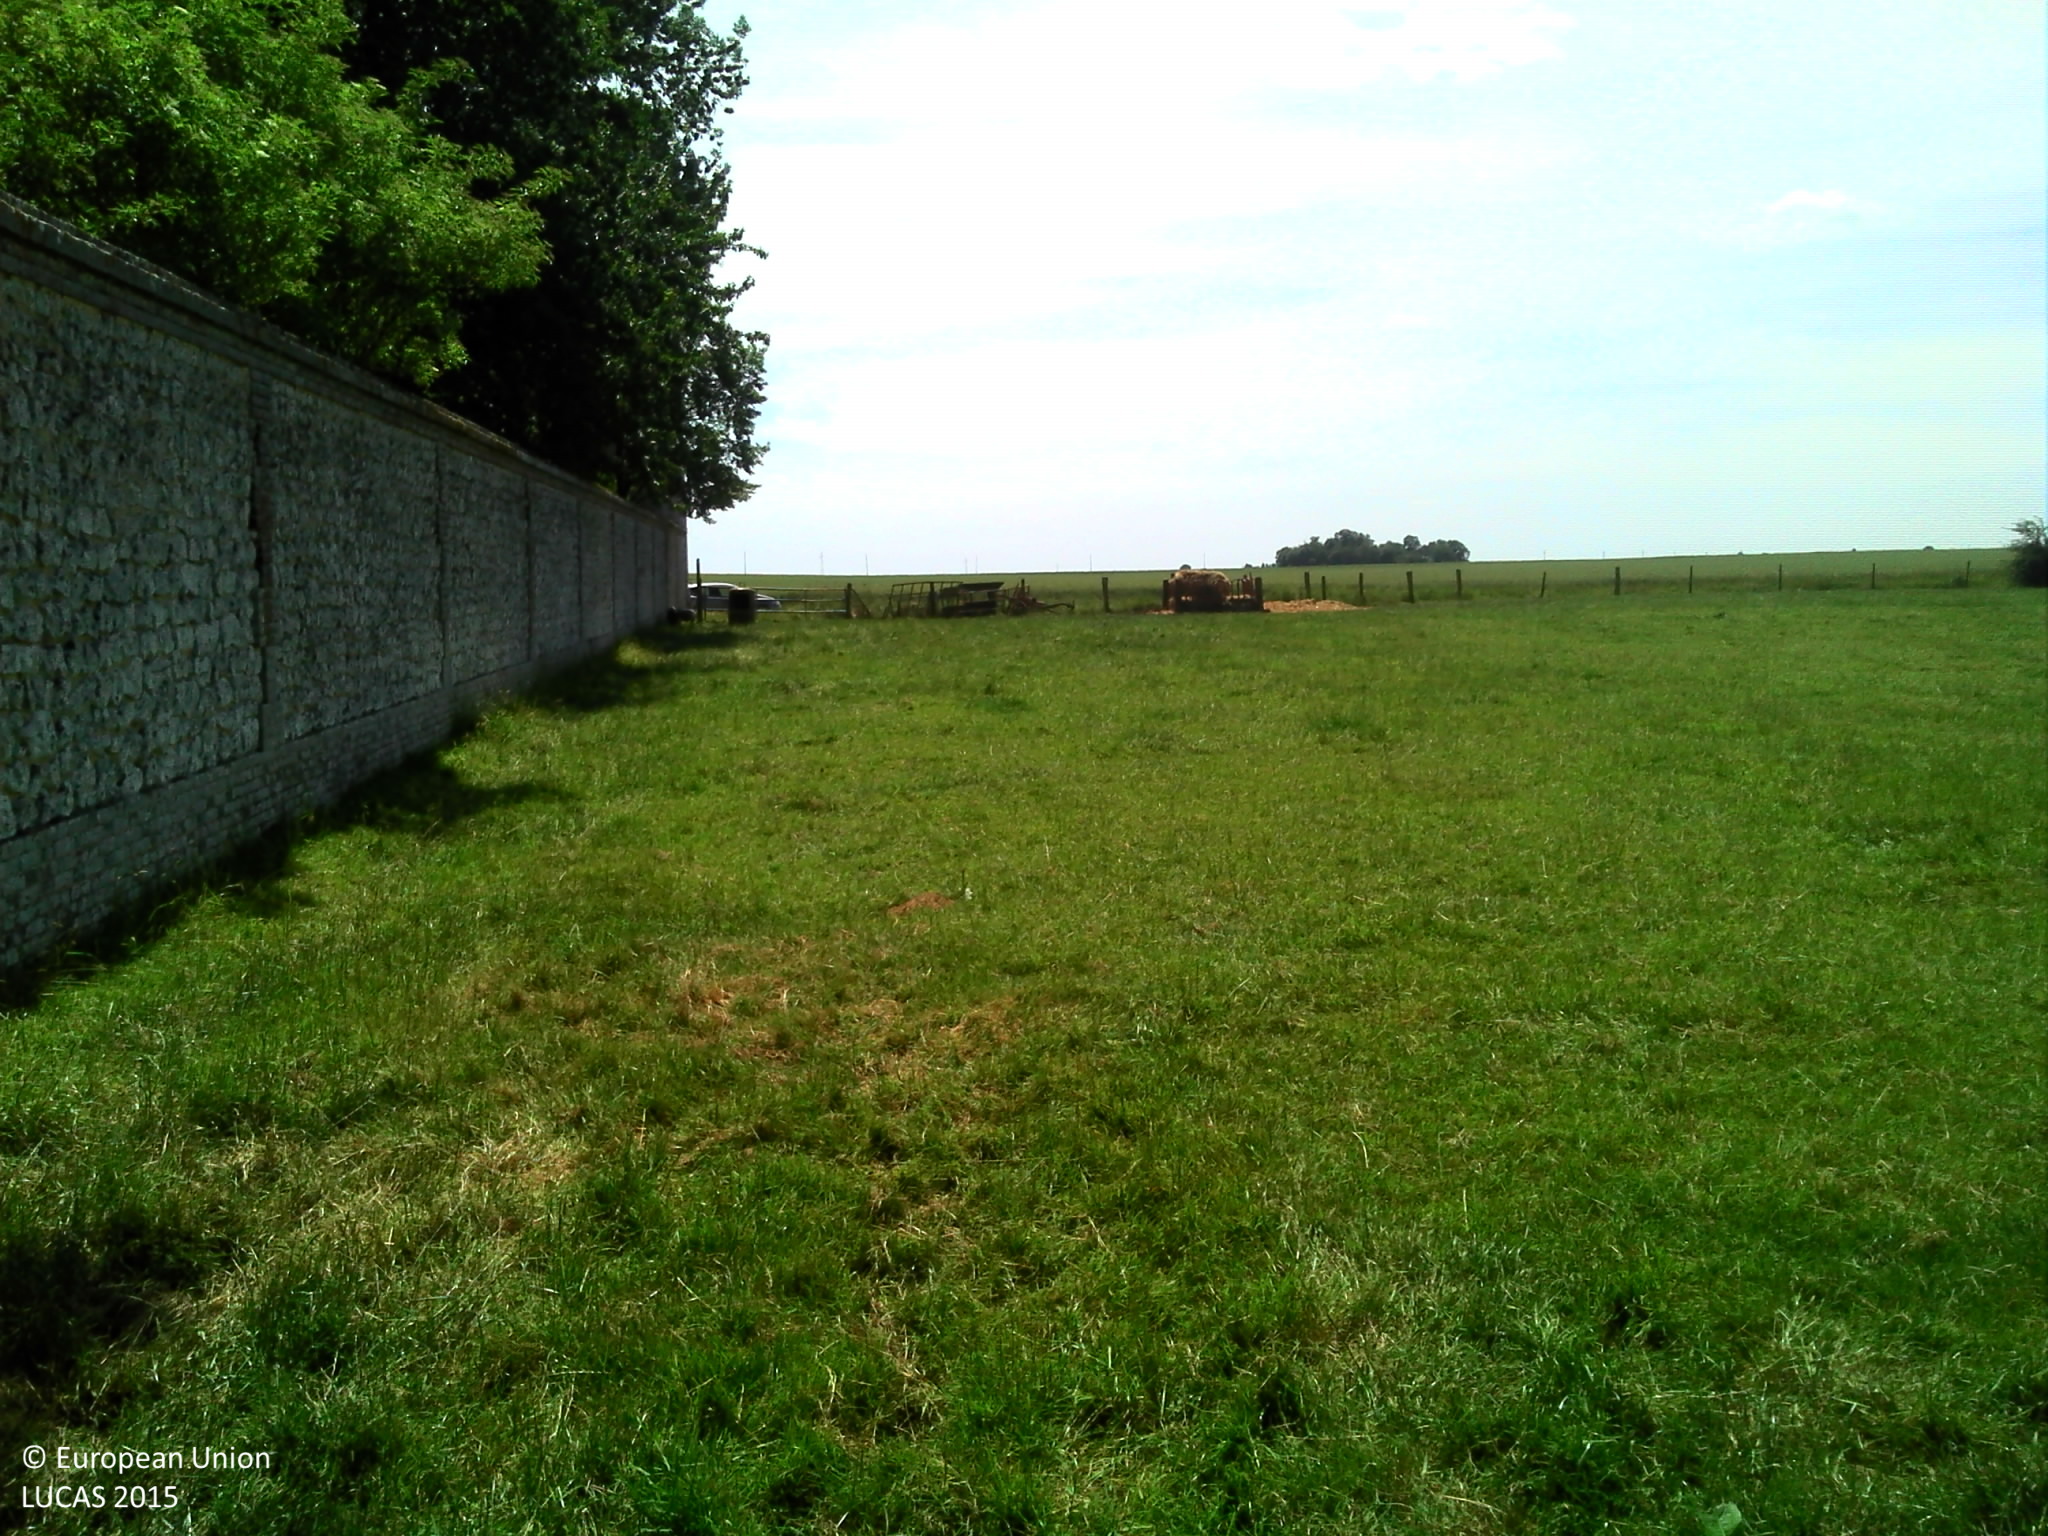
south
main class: Woodland
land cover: Broadleaved woodland
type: mesophytic deciduous forest
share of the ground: > 75 %
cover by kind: broadleaved forest trees 80 %, herbaceous plants 10 %, consolidated bare surface 10 %
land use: Forestry
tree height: > 5 m
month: June
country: FR
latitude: 49.1087
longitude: 1.0608
